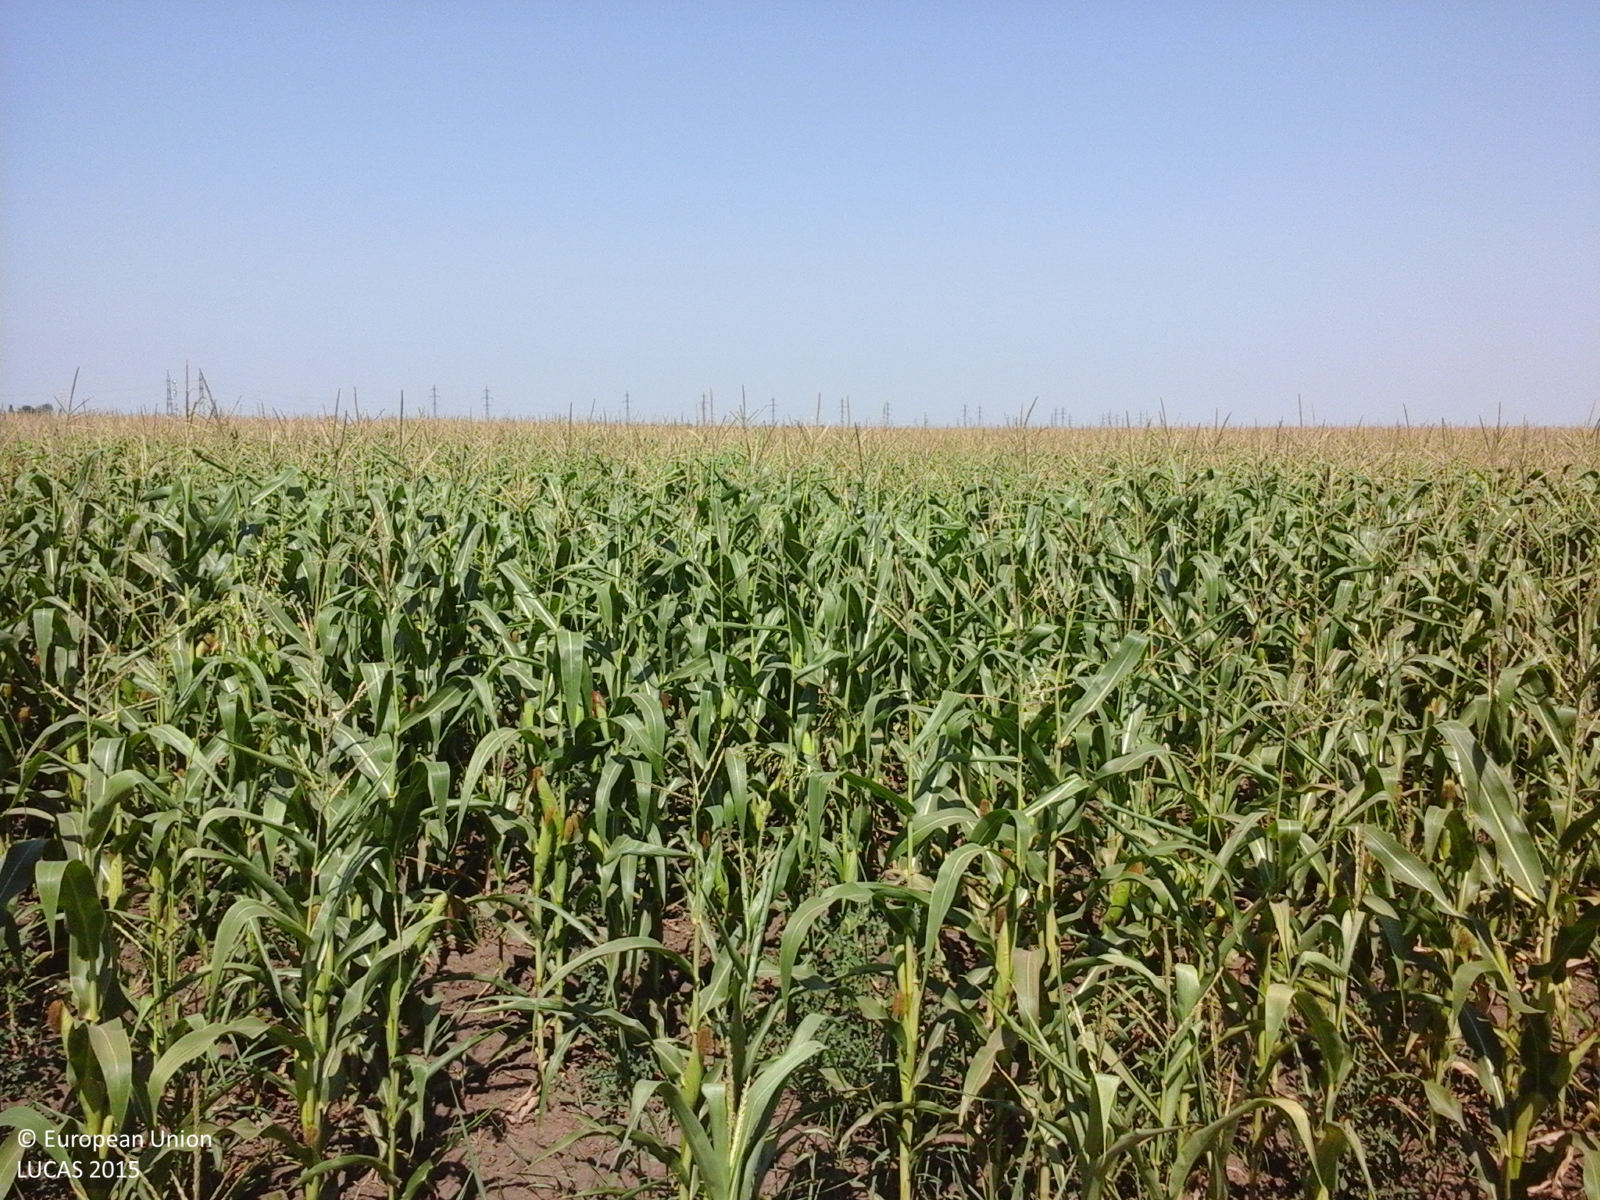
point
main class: Cropland
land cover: Maize
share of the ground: > 75 %
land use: Agriculture (excluding fallow land and kitchen gardens)
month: July
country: RO
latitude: 44.3315
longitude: 27.1233
